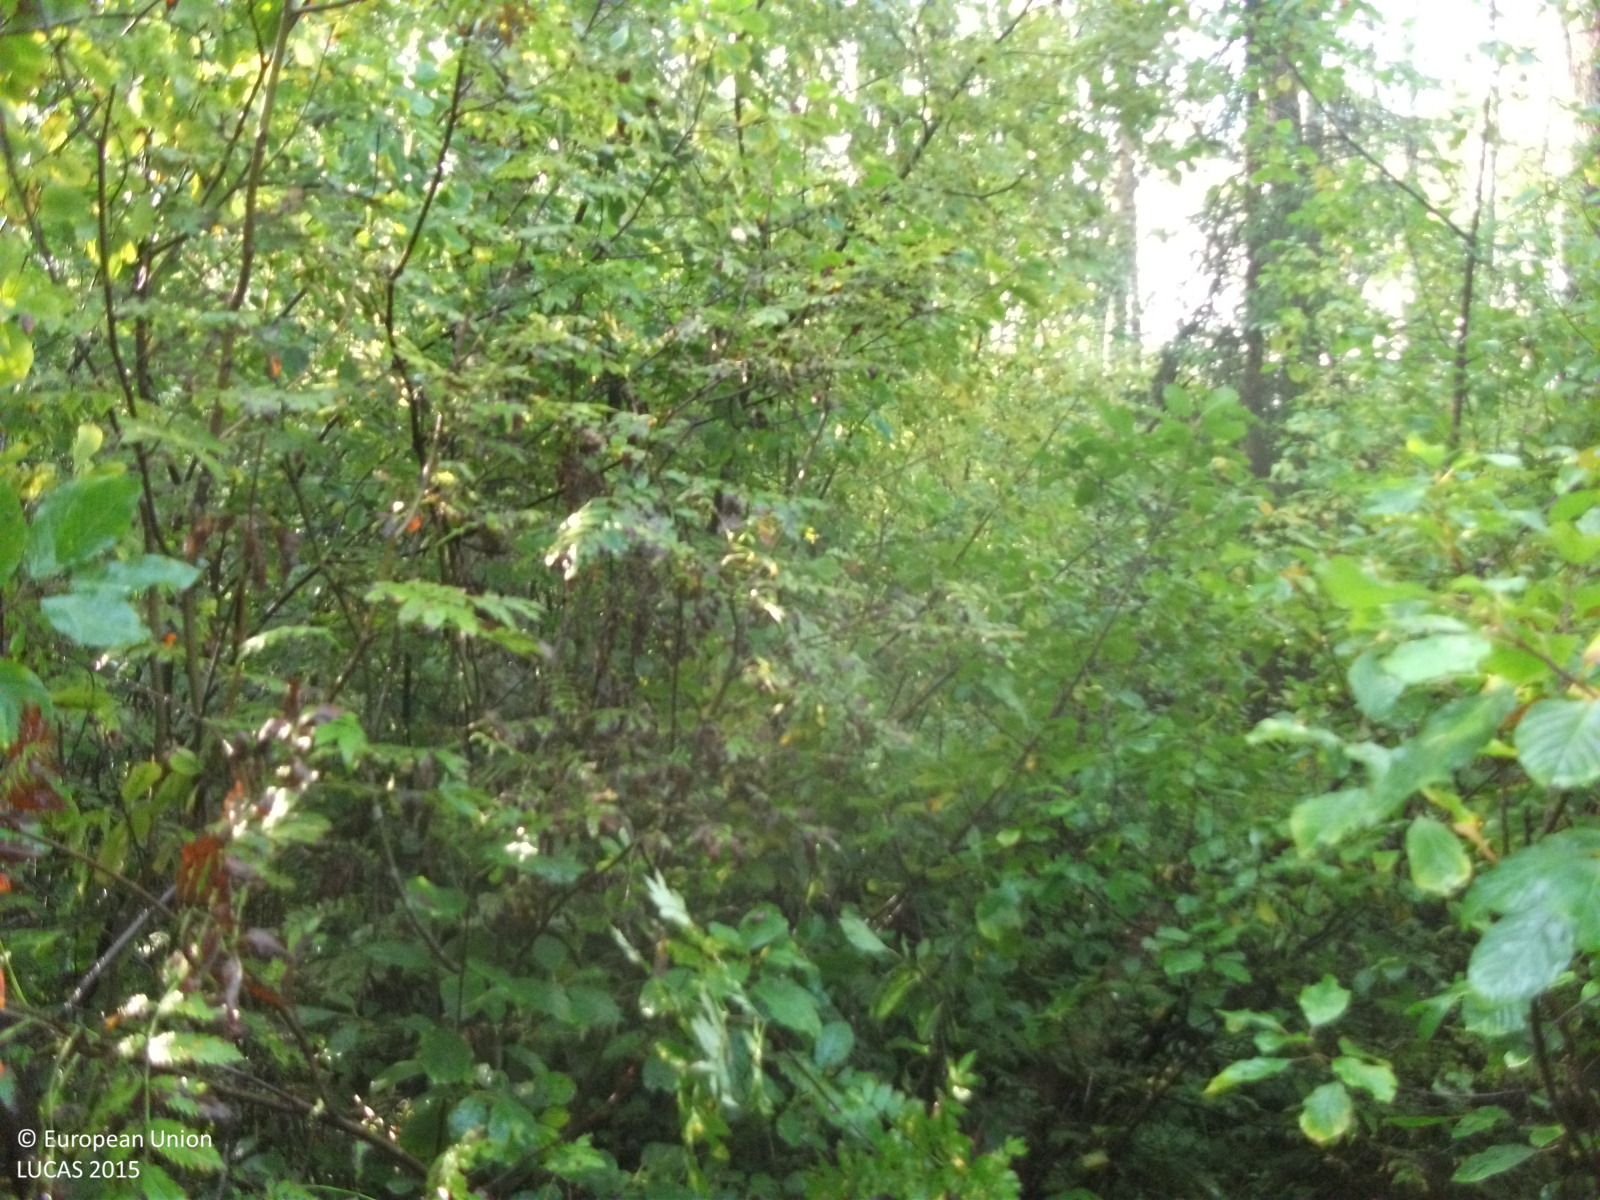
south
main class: Woodland
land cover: Broadleaved woodland
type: non-riverine alder, birch or aspen forest
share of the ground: 50 - 75 %
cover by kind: broadleaved forest trees 55 %, shrubs 30 %, coniferous forest trees 15 %
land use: Forestry
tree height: > 5 m
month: September
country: LV
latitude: 57.5495
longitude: 24.7168
